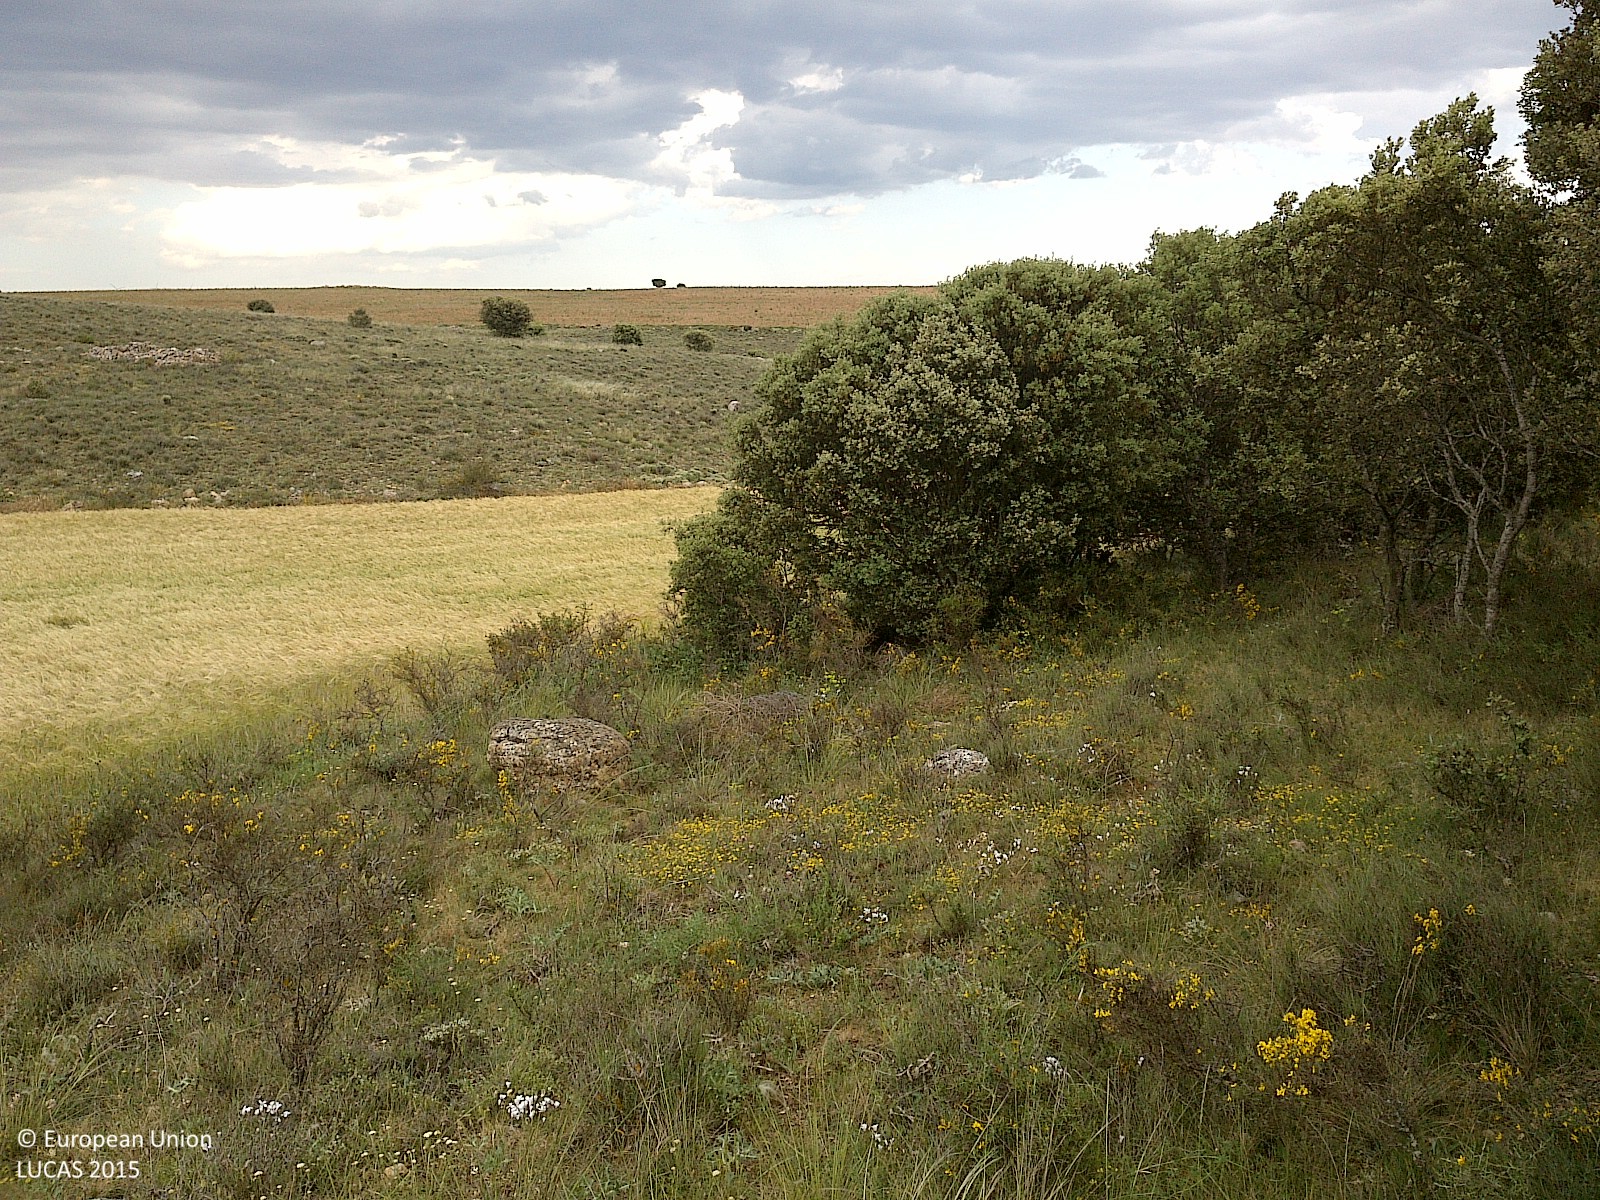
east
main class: Woodland
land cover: Broadleaved woodland
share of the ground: 25 - 50 %
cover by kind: herbaceous plants 50 %, broadleaved forest trees 40 %, shrubs 10 %
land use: Semi-natural and natural areas not in use
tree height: < 5 m
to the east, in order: Broadleaved woodland; Barley; Grassland without tree/shrub cover; Barley; Grass margins; Rock outcrops; Tracks; Grassland without tree/shrub cover; Tracks; Grassland without tree/shrub cover; Tracks; Grassland without tree/shrub cover; Dry stone walls; Grass margins; Other bare soil
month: June
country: ES
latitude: 41.7236
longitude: -2.2605
